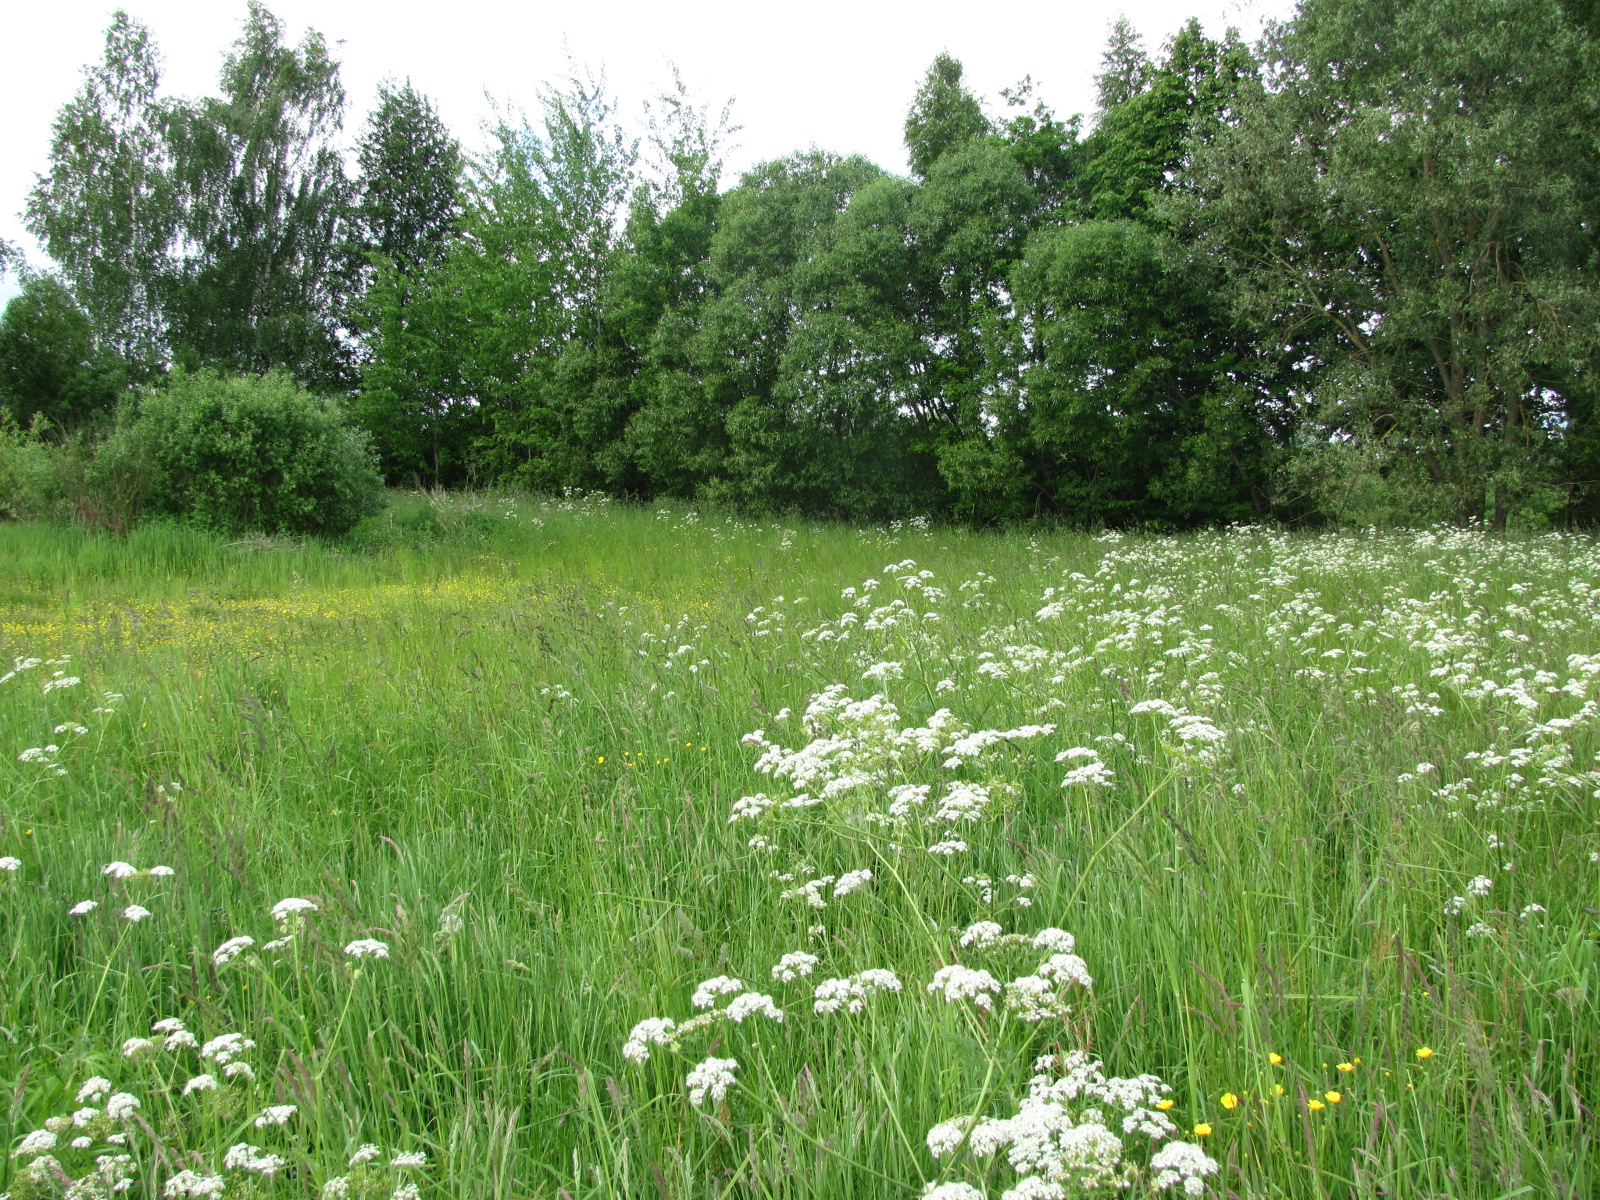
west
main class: Grassland
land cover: Grassland without tree/shrub cover
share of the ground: > 75 %
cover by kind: herbaceous plants 100 %
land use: Agriculture (excluding fallow land and kitchen gardens)
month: June
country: LV
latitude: 56.6757
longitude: 23.8396
